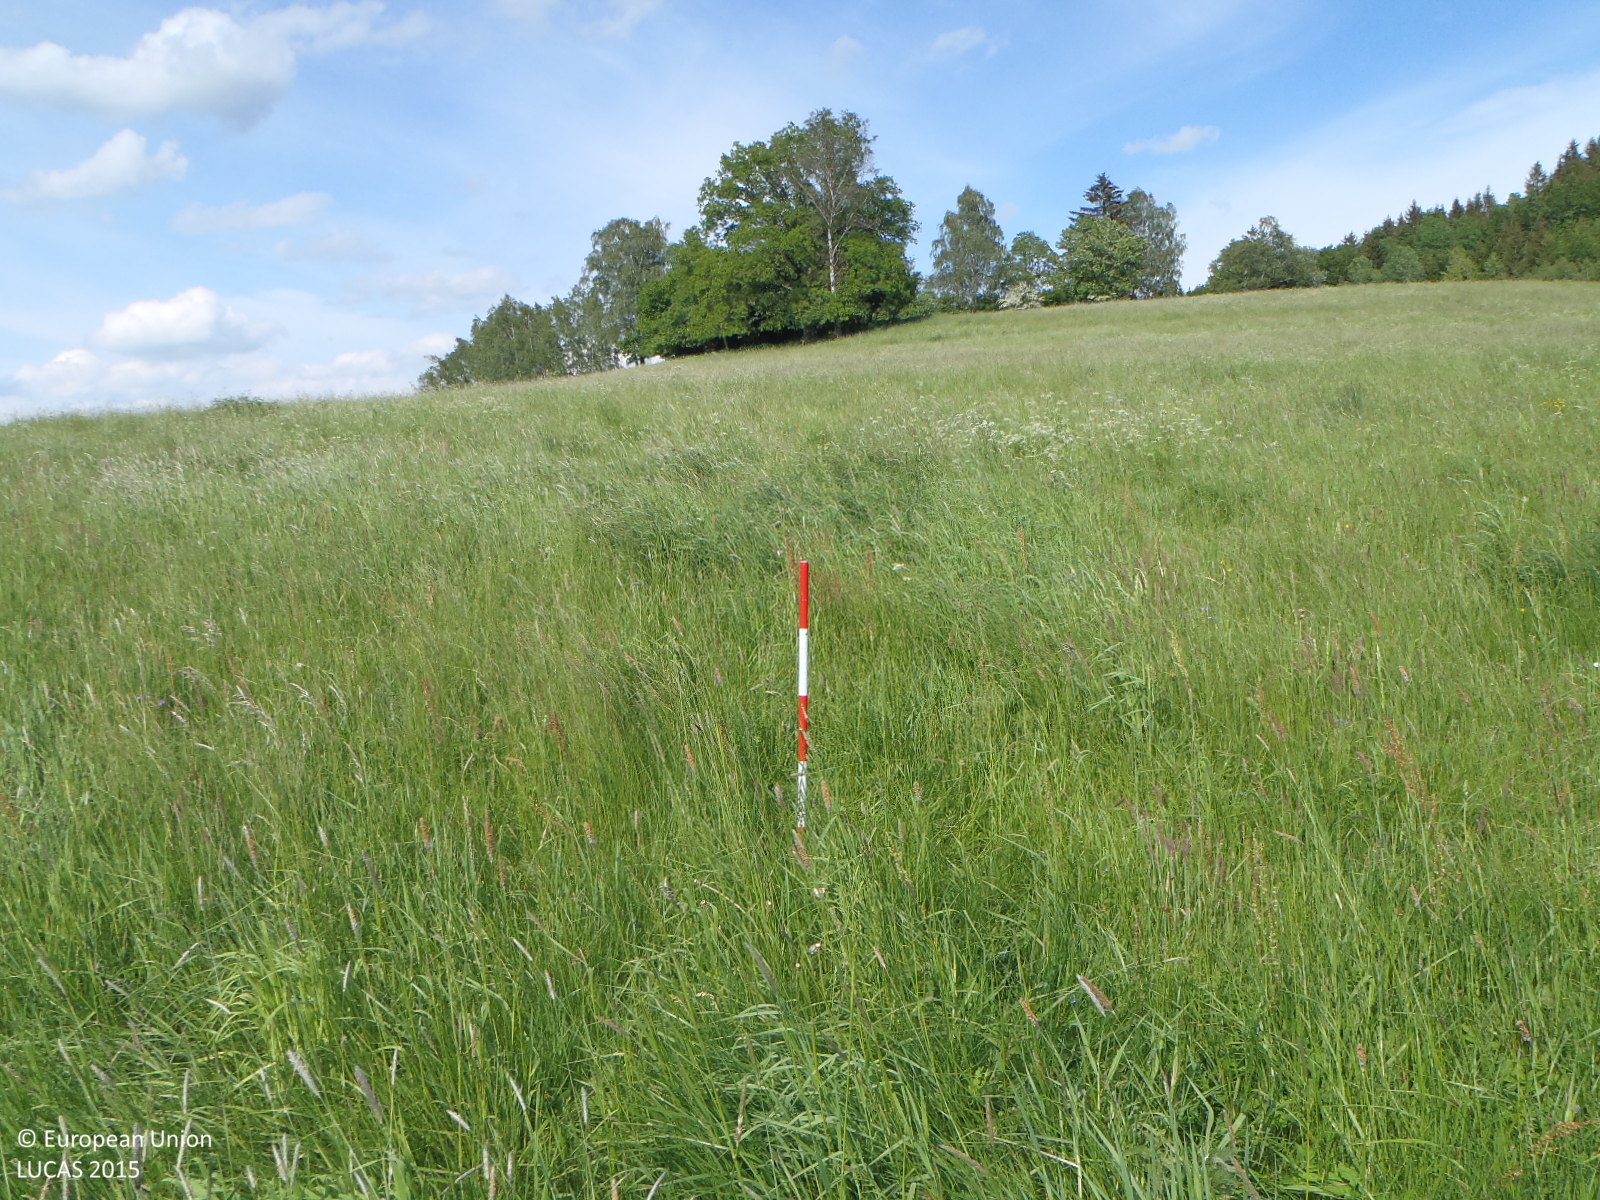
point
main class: Grassland
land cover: Grassland without tree/shrub cover
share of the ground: > 75 %
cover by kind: herbaceous plants 100 %
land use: Agriculture (excluding fallow land and kitchen gardens)
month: June
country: CZ
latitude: 48.6219
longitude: 14.4097
